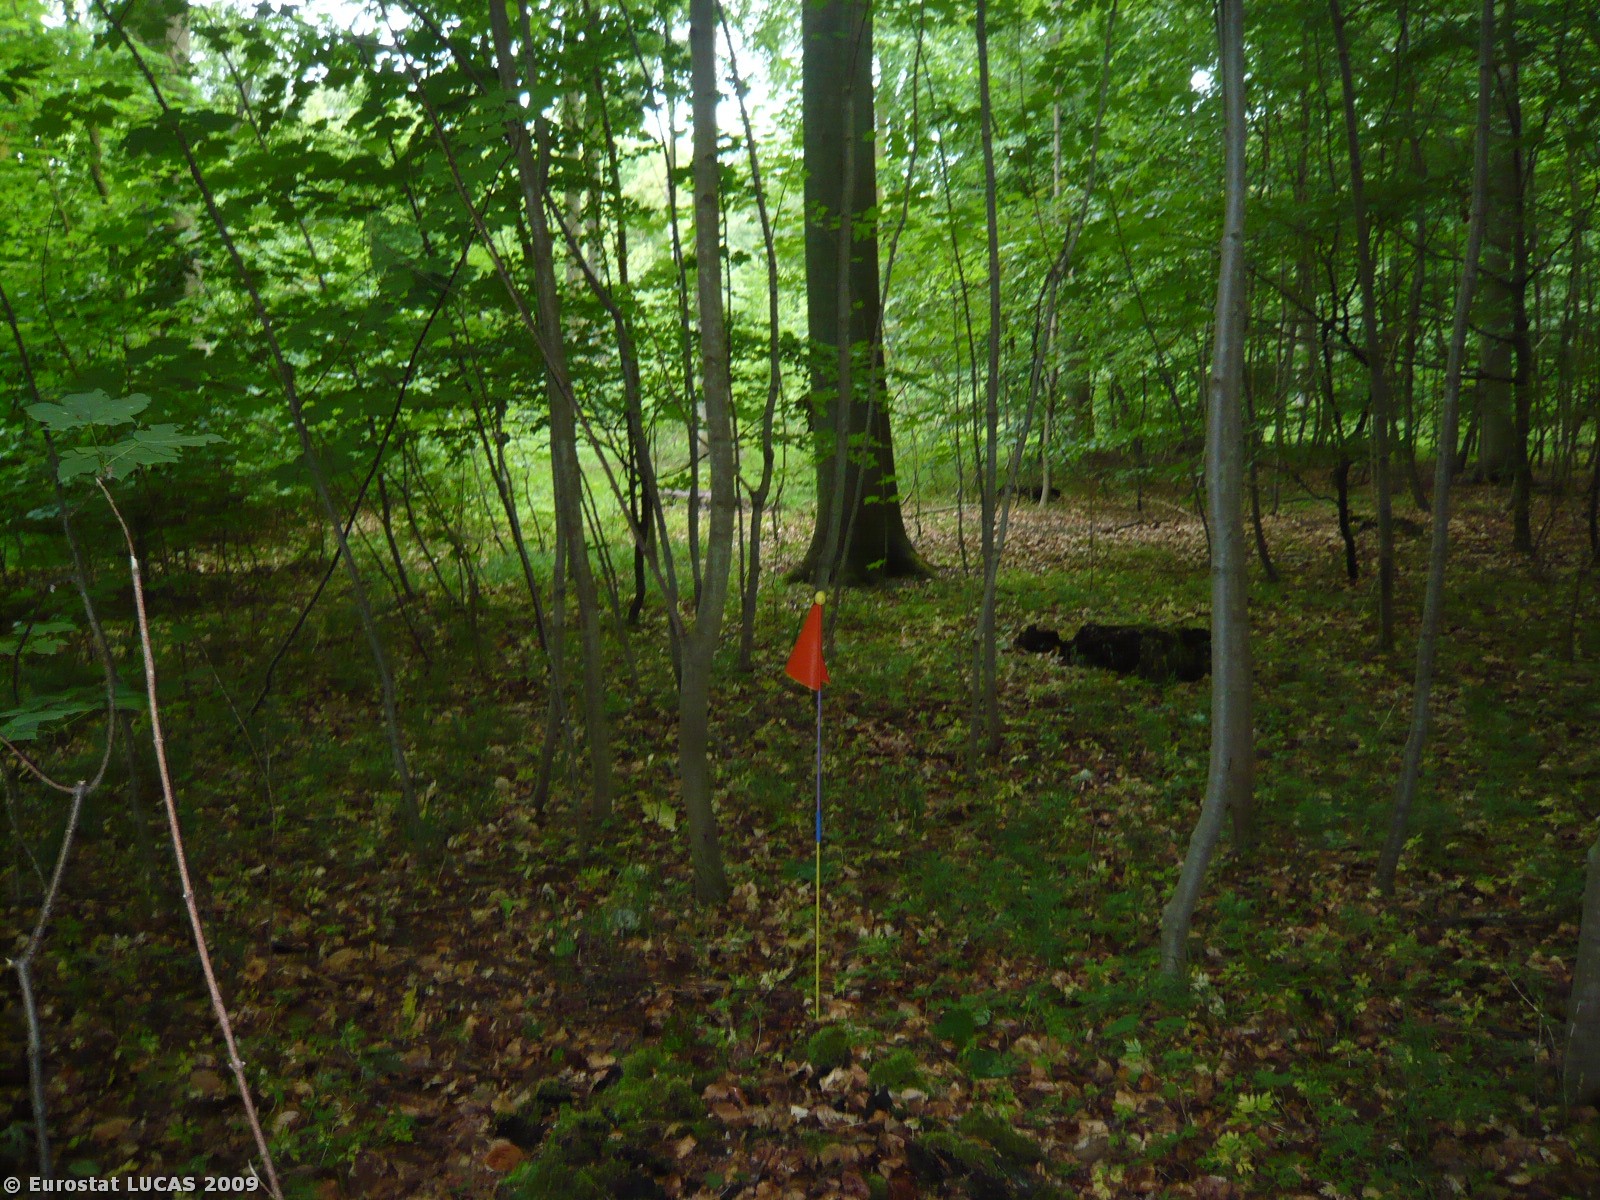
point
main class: Woodland
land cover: Broadleaved woodland
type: mesophytic deciduous forest
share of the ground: > 75 %
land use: Forestry
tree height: > 5 m
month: June
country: DK
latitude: 54.7007
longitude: 11.8144
